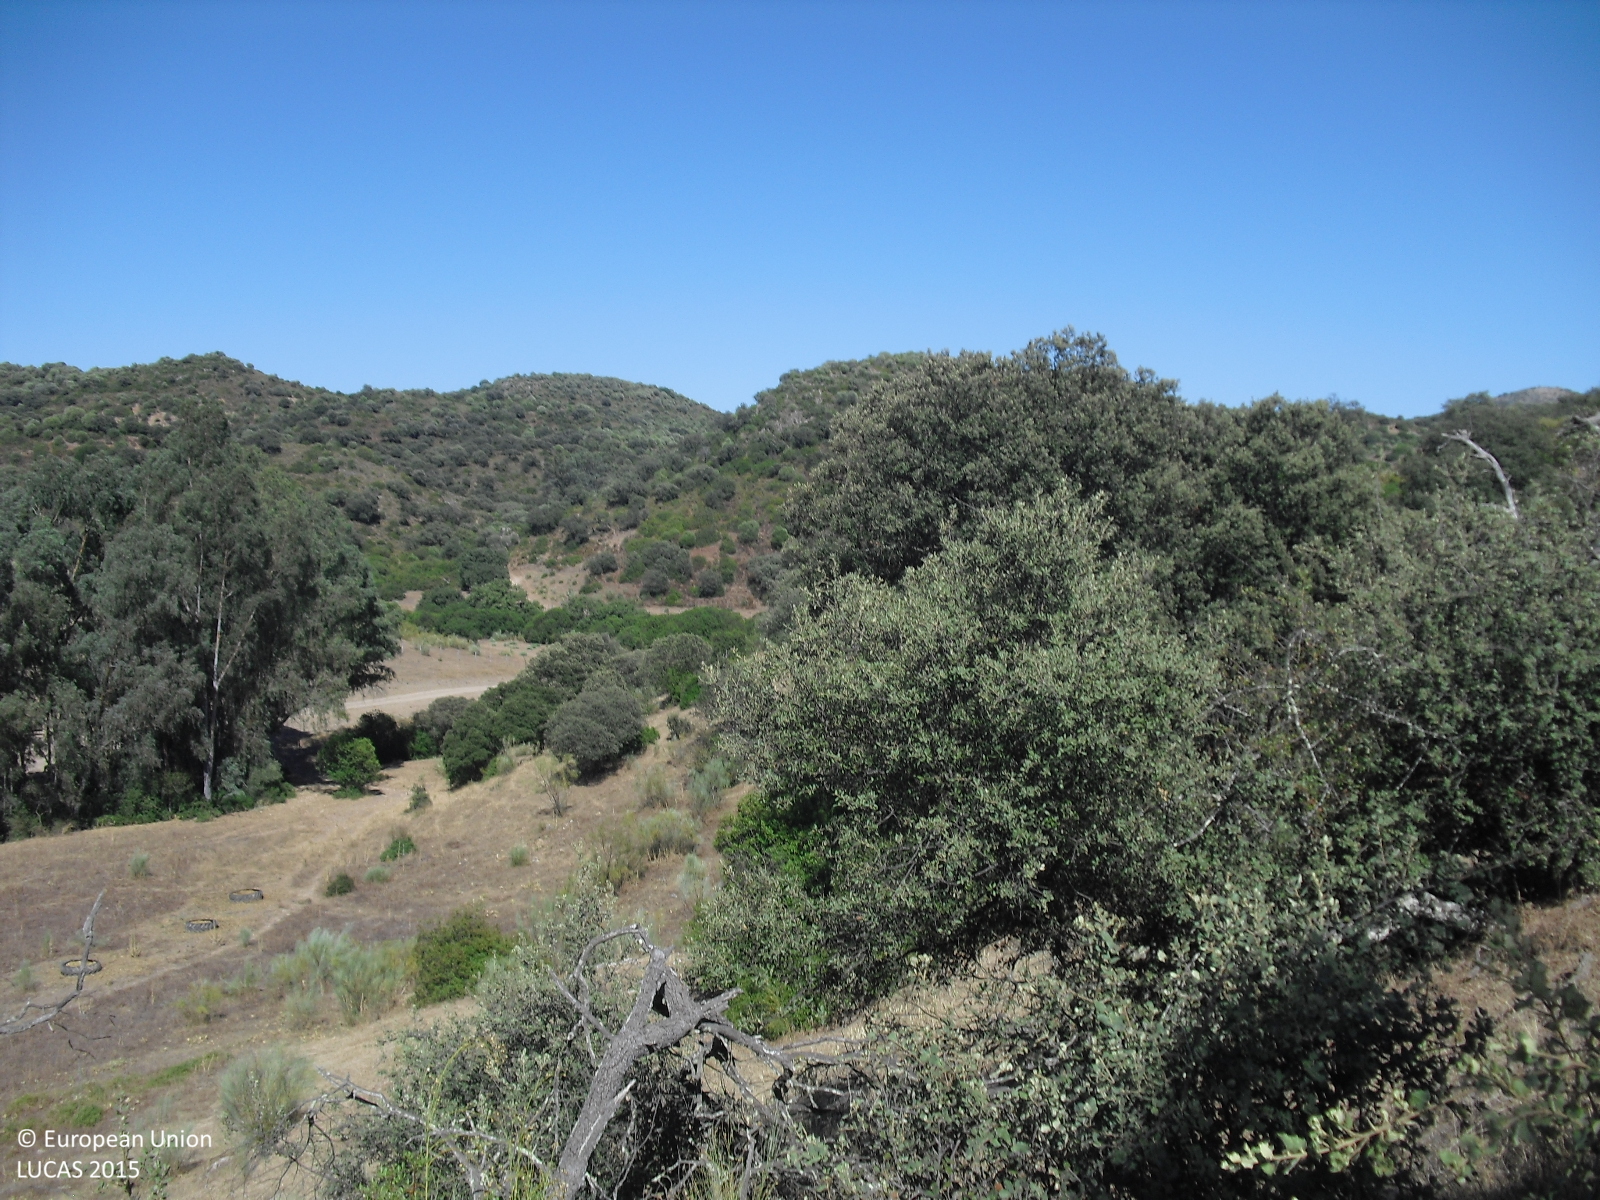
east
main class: Woodland
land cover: Broadleaved woodland
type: broadleaved evergreen forest
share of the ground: 10 - 25 %
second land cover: Shrubland without tree cover
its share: 25 - 50 %
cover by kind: herbaceous plants 55 %, shrubs 30 %, broadleaved forest trees 10 %, unconsolidated bare surface 5 %
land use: Forestry
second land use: Agriculture (excluding fallow land and kitchen gardens)
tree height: < 5 m
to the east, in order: Broadleaved woodland; Shrubland without tree cover; Other structural elements; Broadleaved woodland; Rivers and streams; Shrubland with sparse tree cover
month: July
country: ES
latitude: 37.0877
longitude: -5.3189
